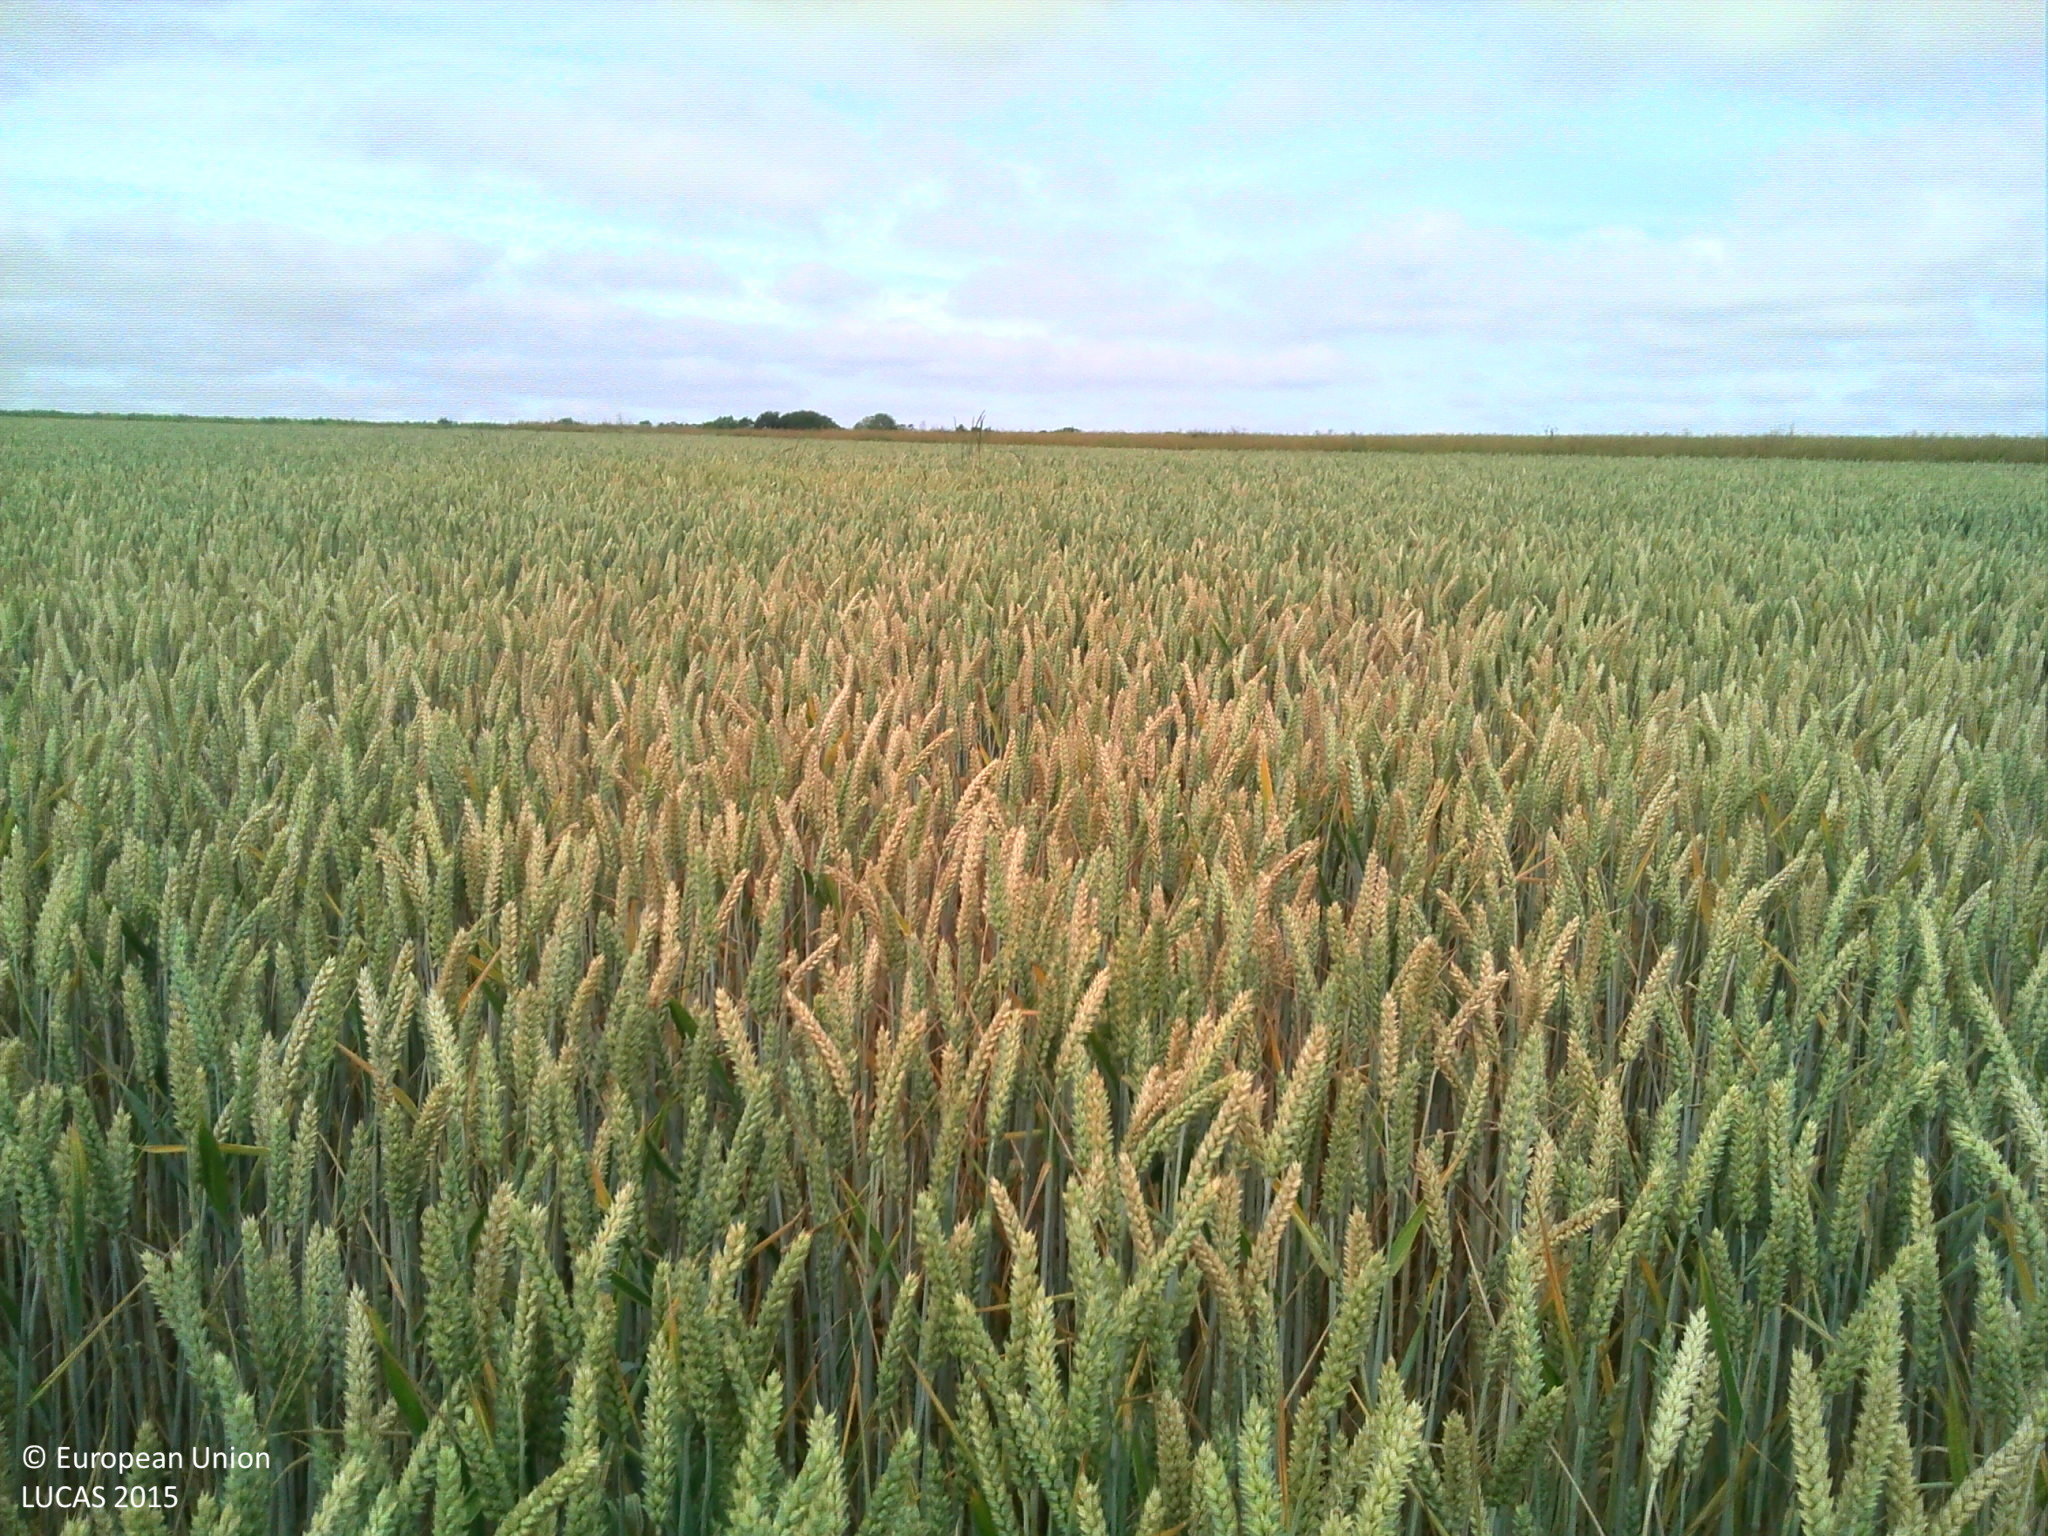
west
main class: Cropland
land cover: Common wheat
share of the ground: > 75 %
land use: Agriculture (excluding fallow land and kitchen gardens)
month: June
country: FR
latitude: 49.6335
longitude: 2.5530
